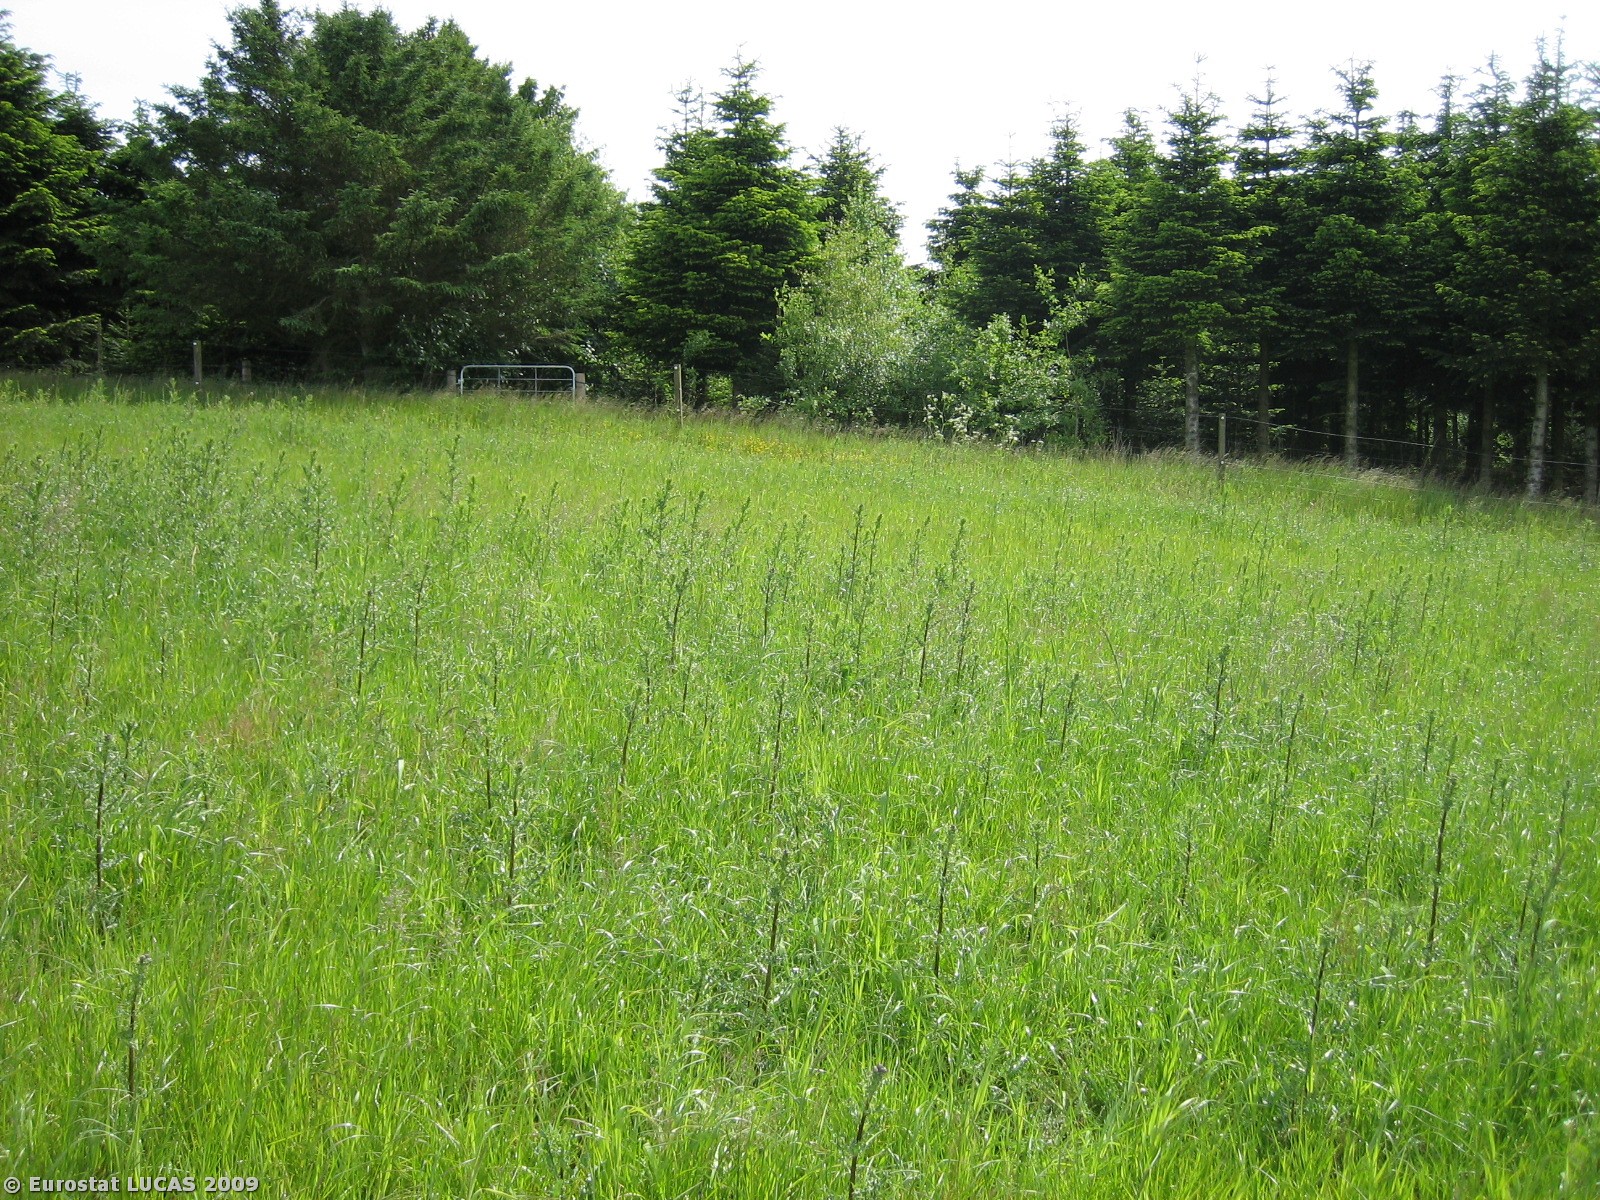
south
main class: Grassland
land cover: Grassland without tree/shrub cover
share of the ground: > 75 %
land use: Agriculture (excluding fallow land and kitchen gardens)
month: June
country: DK
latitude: 56.1875
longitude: 9.7586
